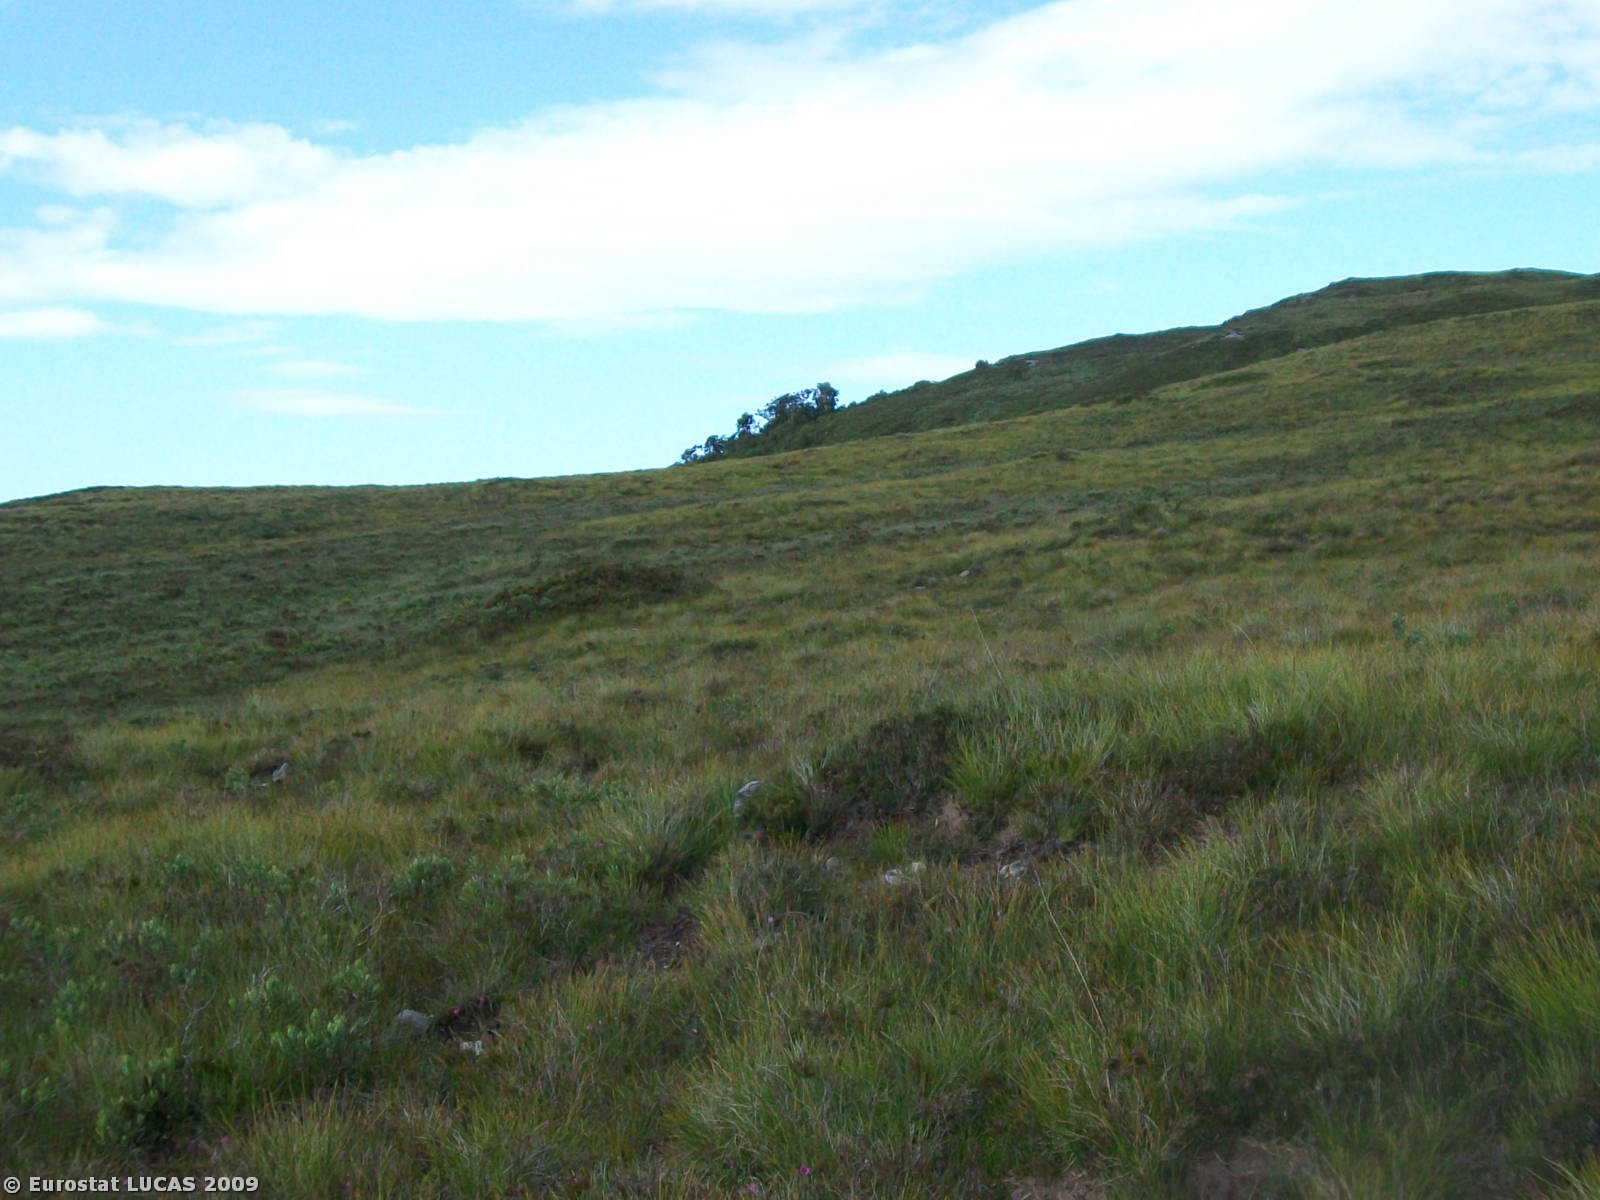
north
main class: Shrubland
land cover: Shrubland without tree cover
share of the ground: > 75 %
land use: Agriculture (excluding fallow land and kitchen gardens)
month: July
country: GB
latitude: 58.4392
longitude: -4.6314
